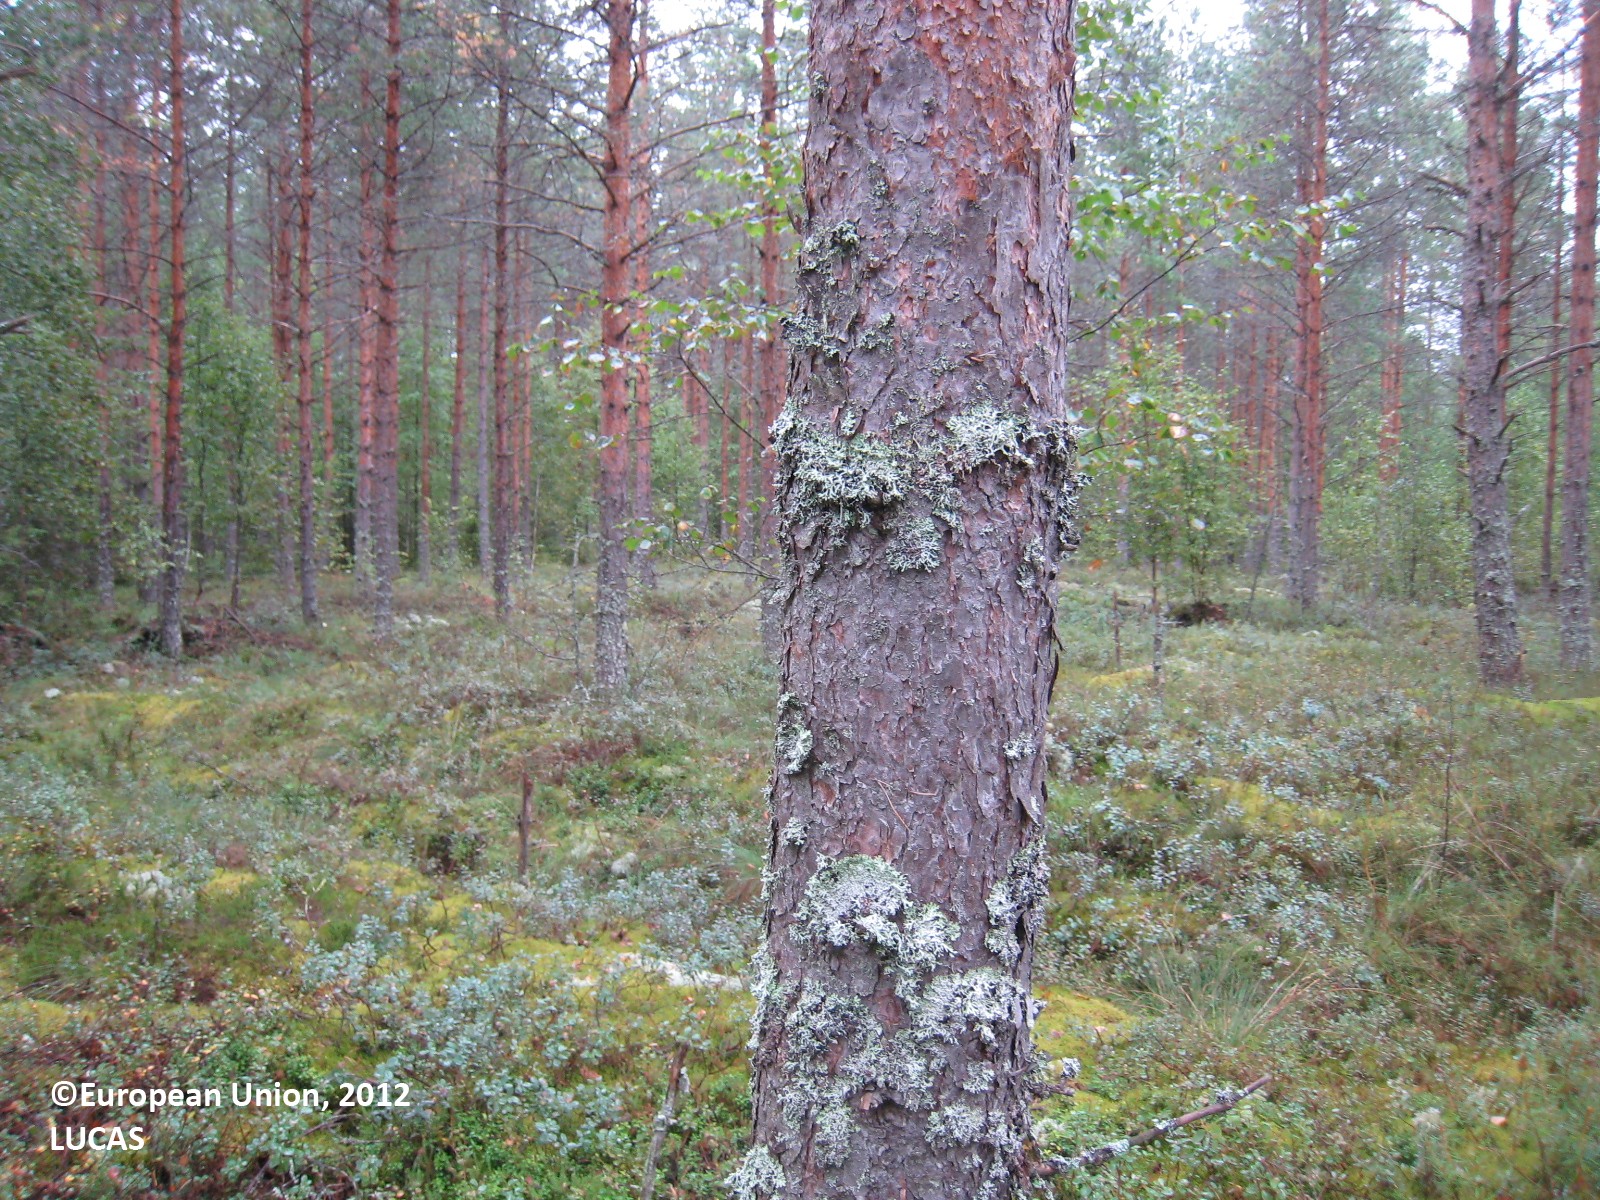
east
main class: Woodland
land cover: Pine dominated coniferous woodland
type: mire and swamp forests
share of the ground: 50 - 75 %
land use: Forestry
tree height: > 5 m
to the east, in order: Pine dominated coniferous woodland; Ditches and canals; Pine dominated coniferous woodland; Ditches and canals; Pine dominated coniferous woodland; Ditches and canals; Pine dominated coniferous woodland; Pine dominated mixed woodland; Ditches and canals; Pine dominated coniferous woodland; Pine dominated mixed woodland; Ditches and canals; Pine dominated mixed woodland; Pine dominated coniferous woodland; Ditches and canals; Pine dominated coniferous woodland; Ditches and canals; Pine dominated mixed woodland
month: August
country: FI
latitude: 61.9083
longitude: 26.2218
